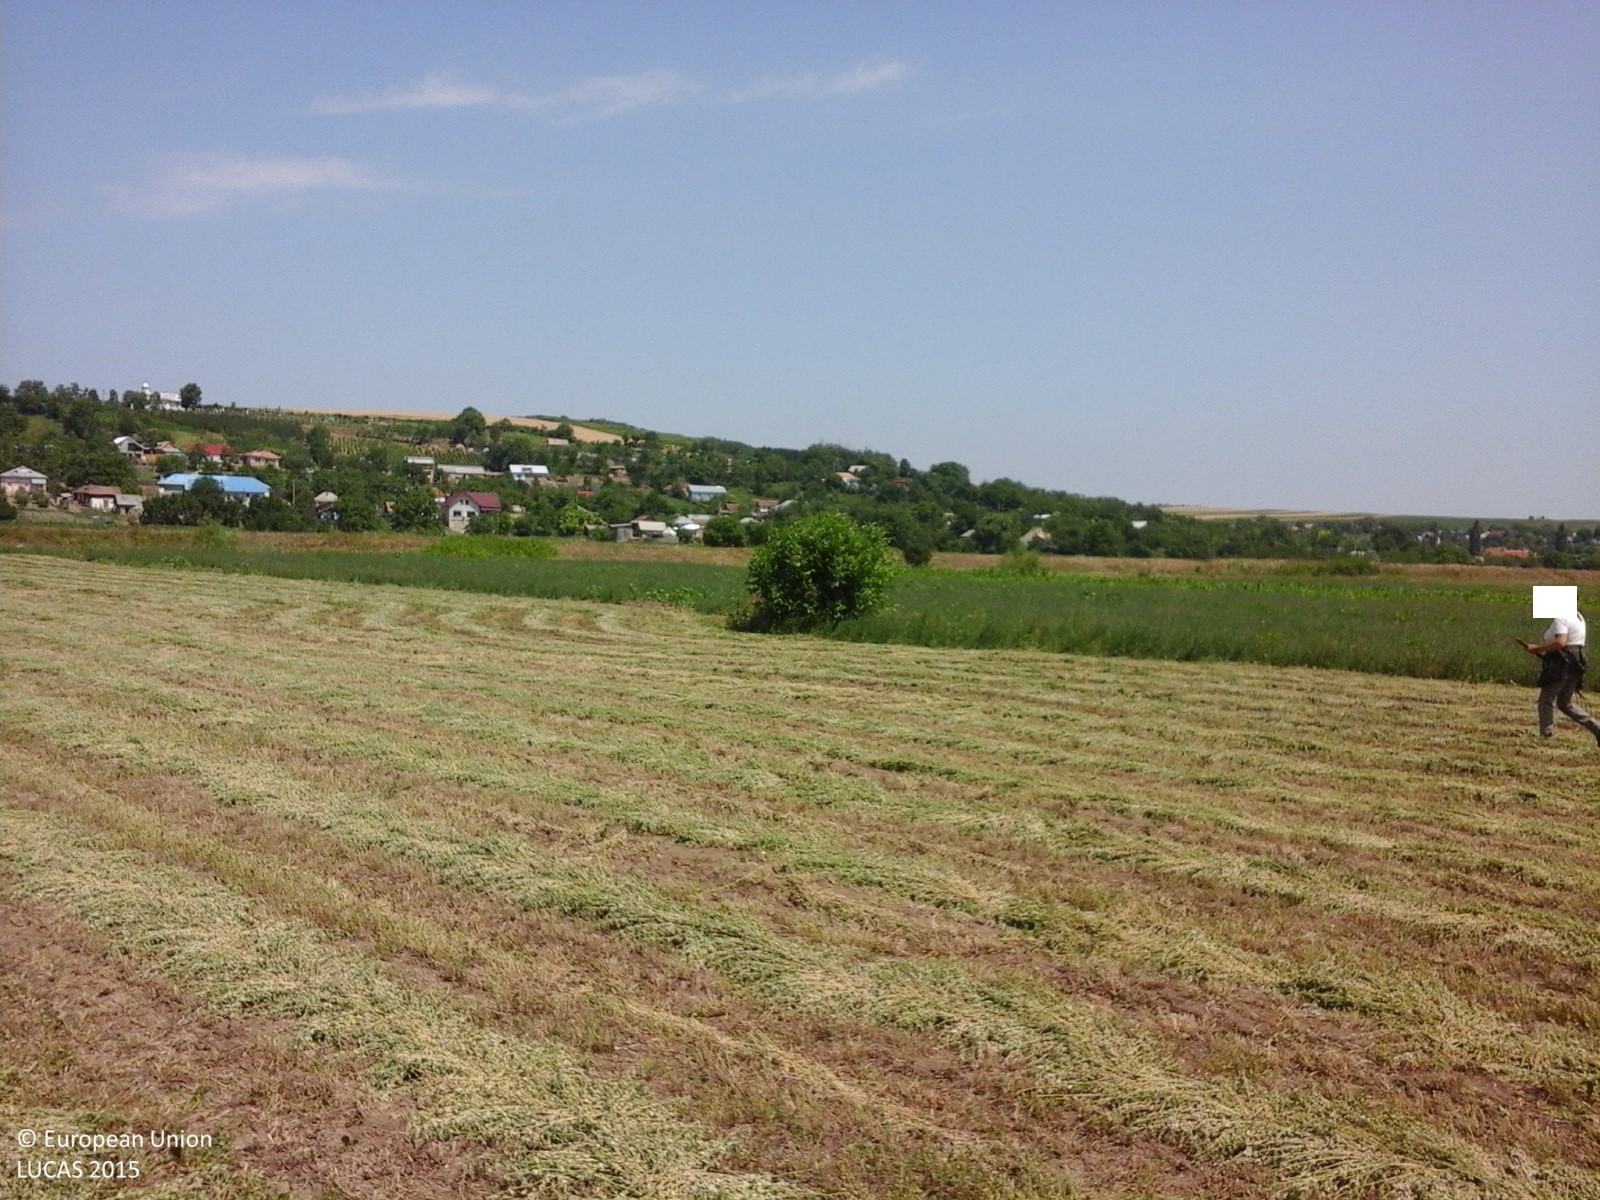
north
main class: Cropland
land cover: Lucerne
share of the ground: > 75 %
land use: Agriculture (excluding fallow land and kitchen gardens)
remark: Harvested field
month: June
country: RO
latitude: 46.8420
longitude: 27.2979
